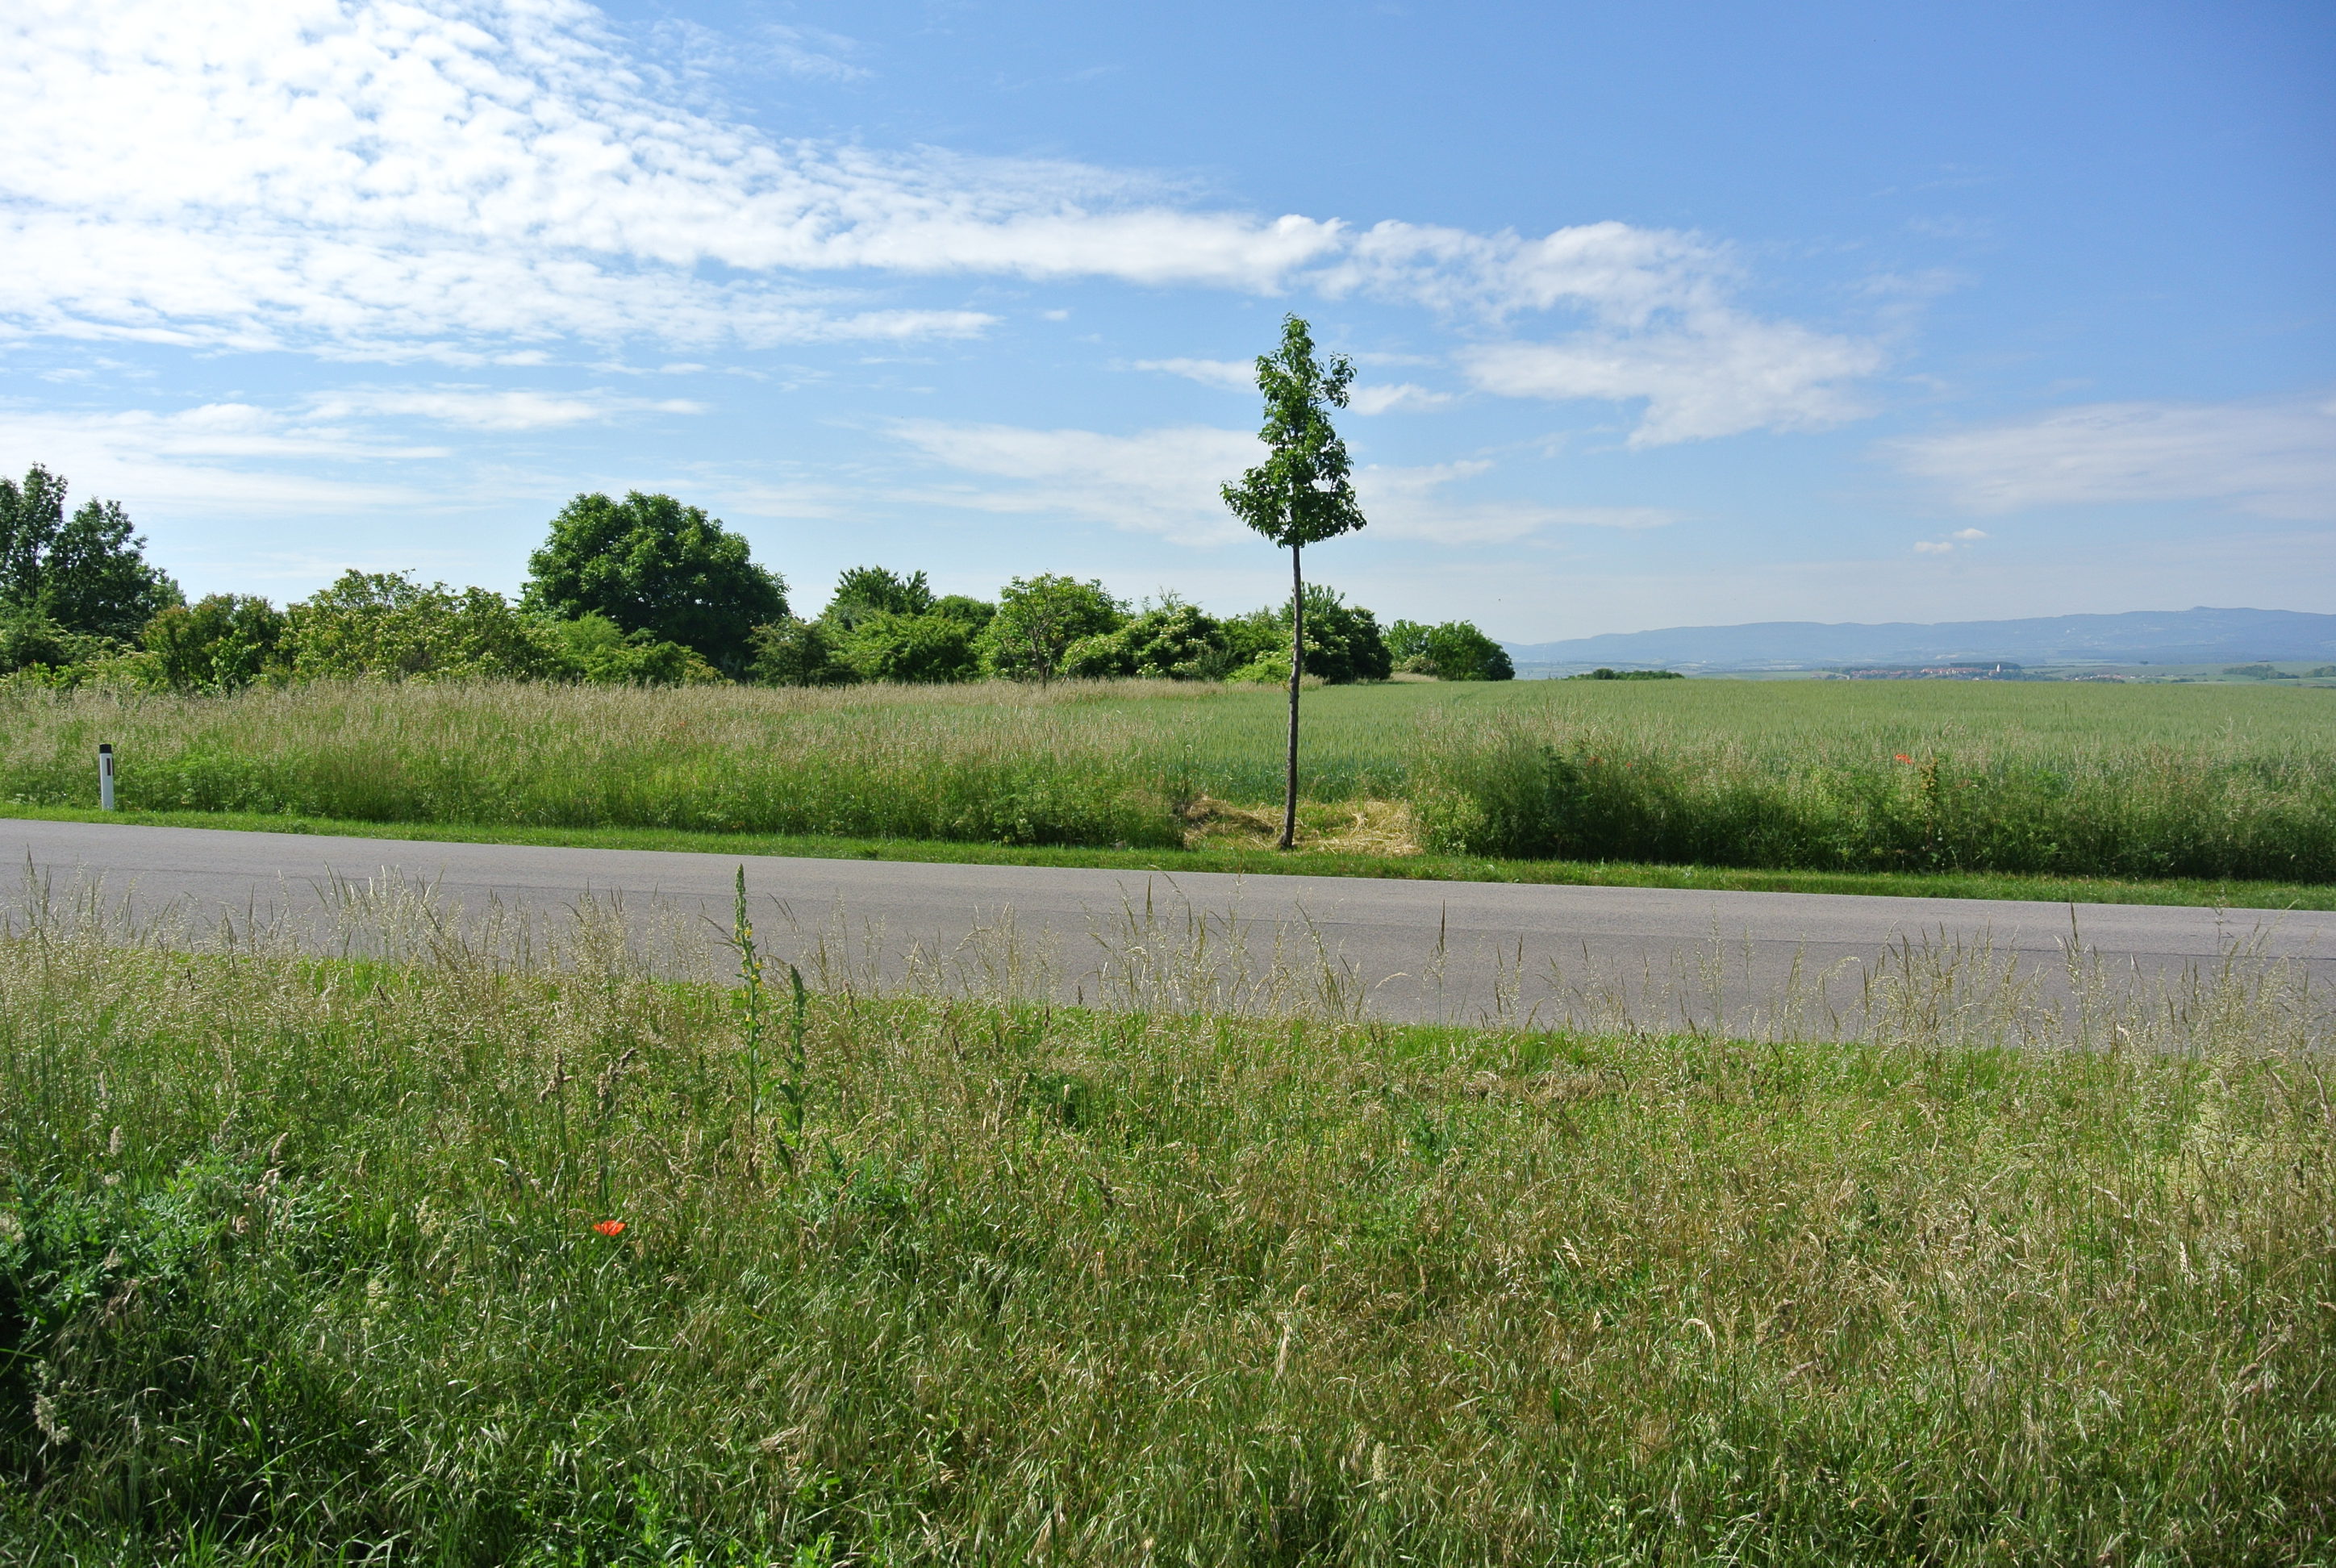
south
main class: Cropland
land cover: Barley
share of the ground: > 75 %
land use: Agriculture (excluding fallow land and kitchen gardens)
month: June
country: AT
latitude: 47.8551
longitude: 16.4332
